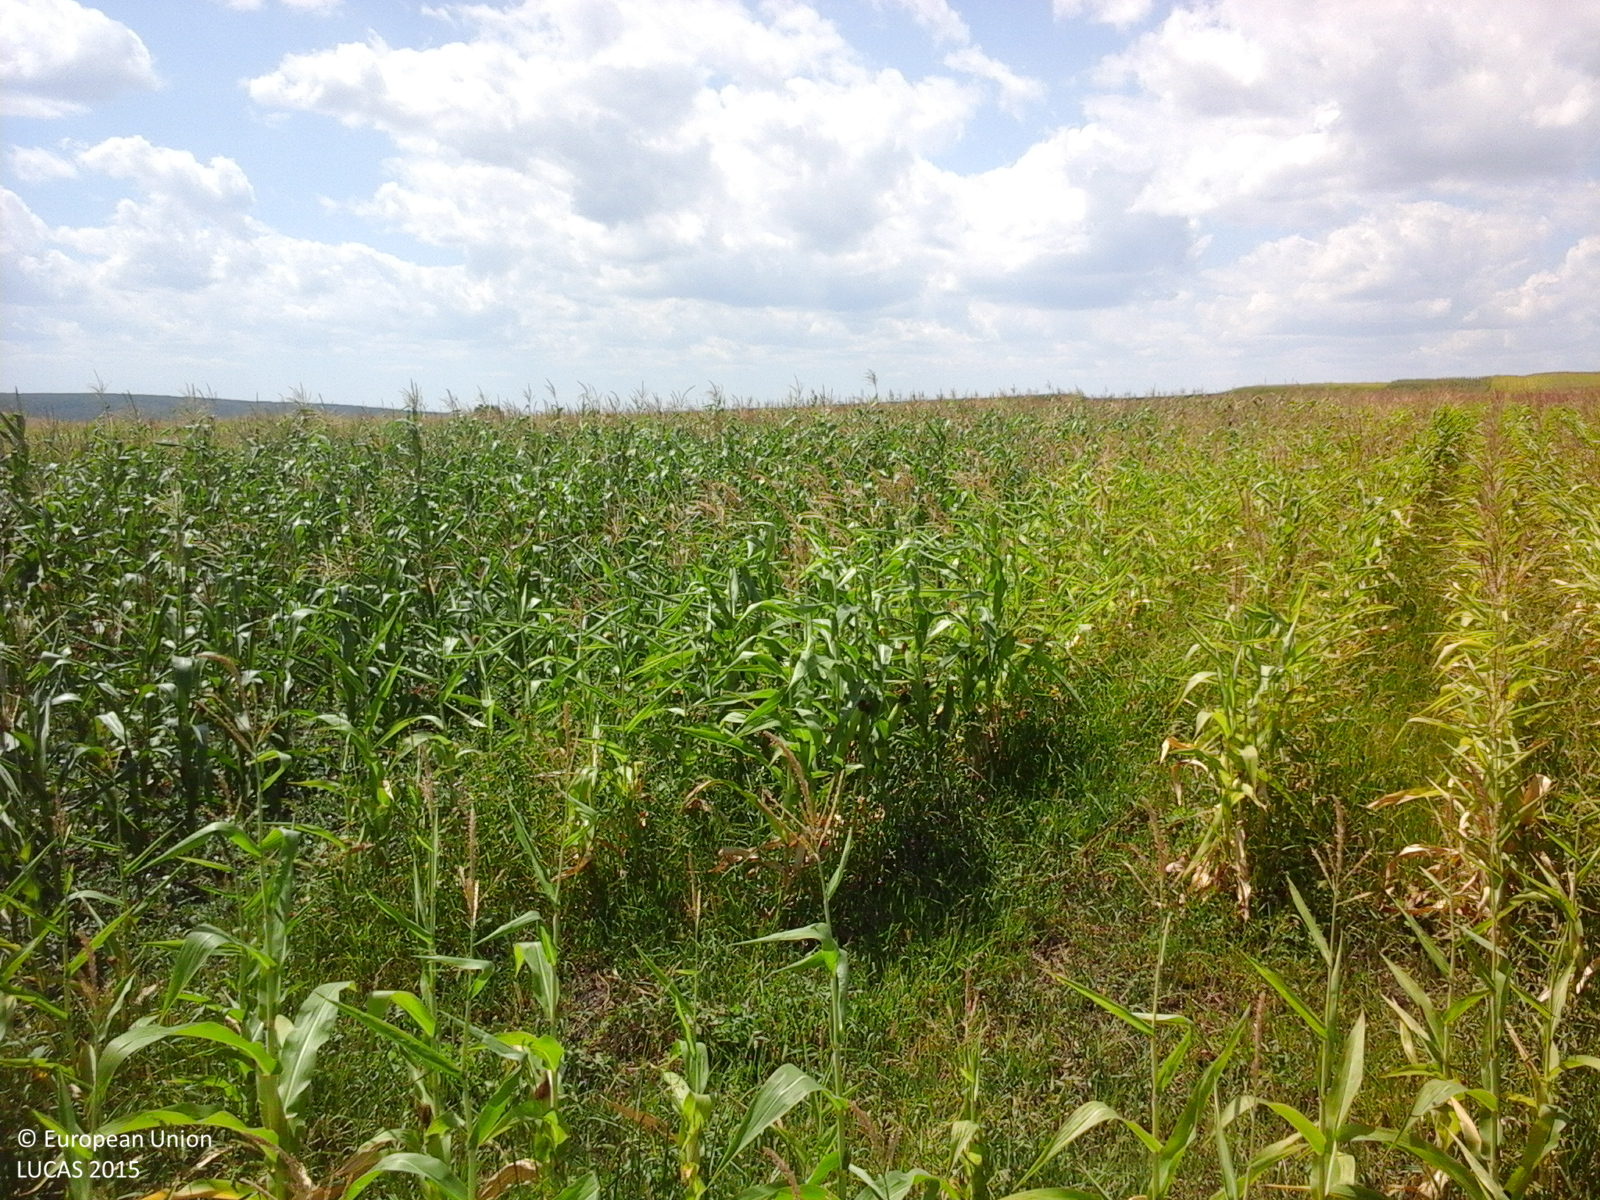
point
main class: Cropland
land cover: Maize
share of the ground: > 75 %
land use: Agriculture (excluding fallow land and kitchen gardens)
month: July
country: RO
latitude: 46.4269
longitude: 27.9115
